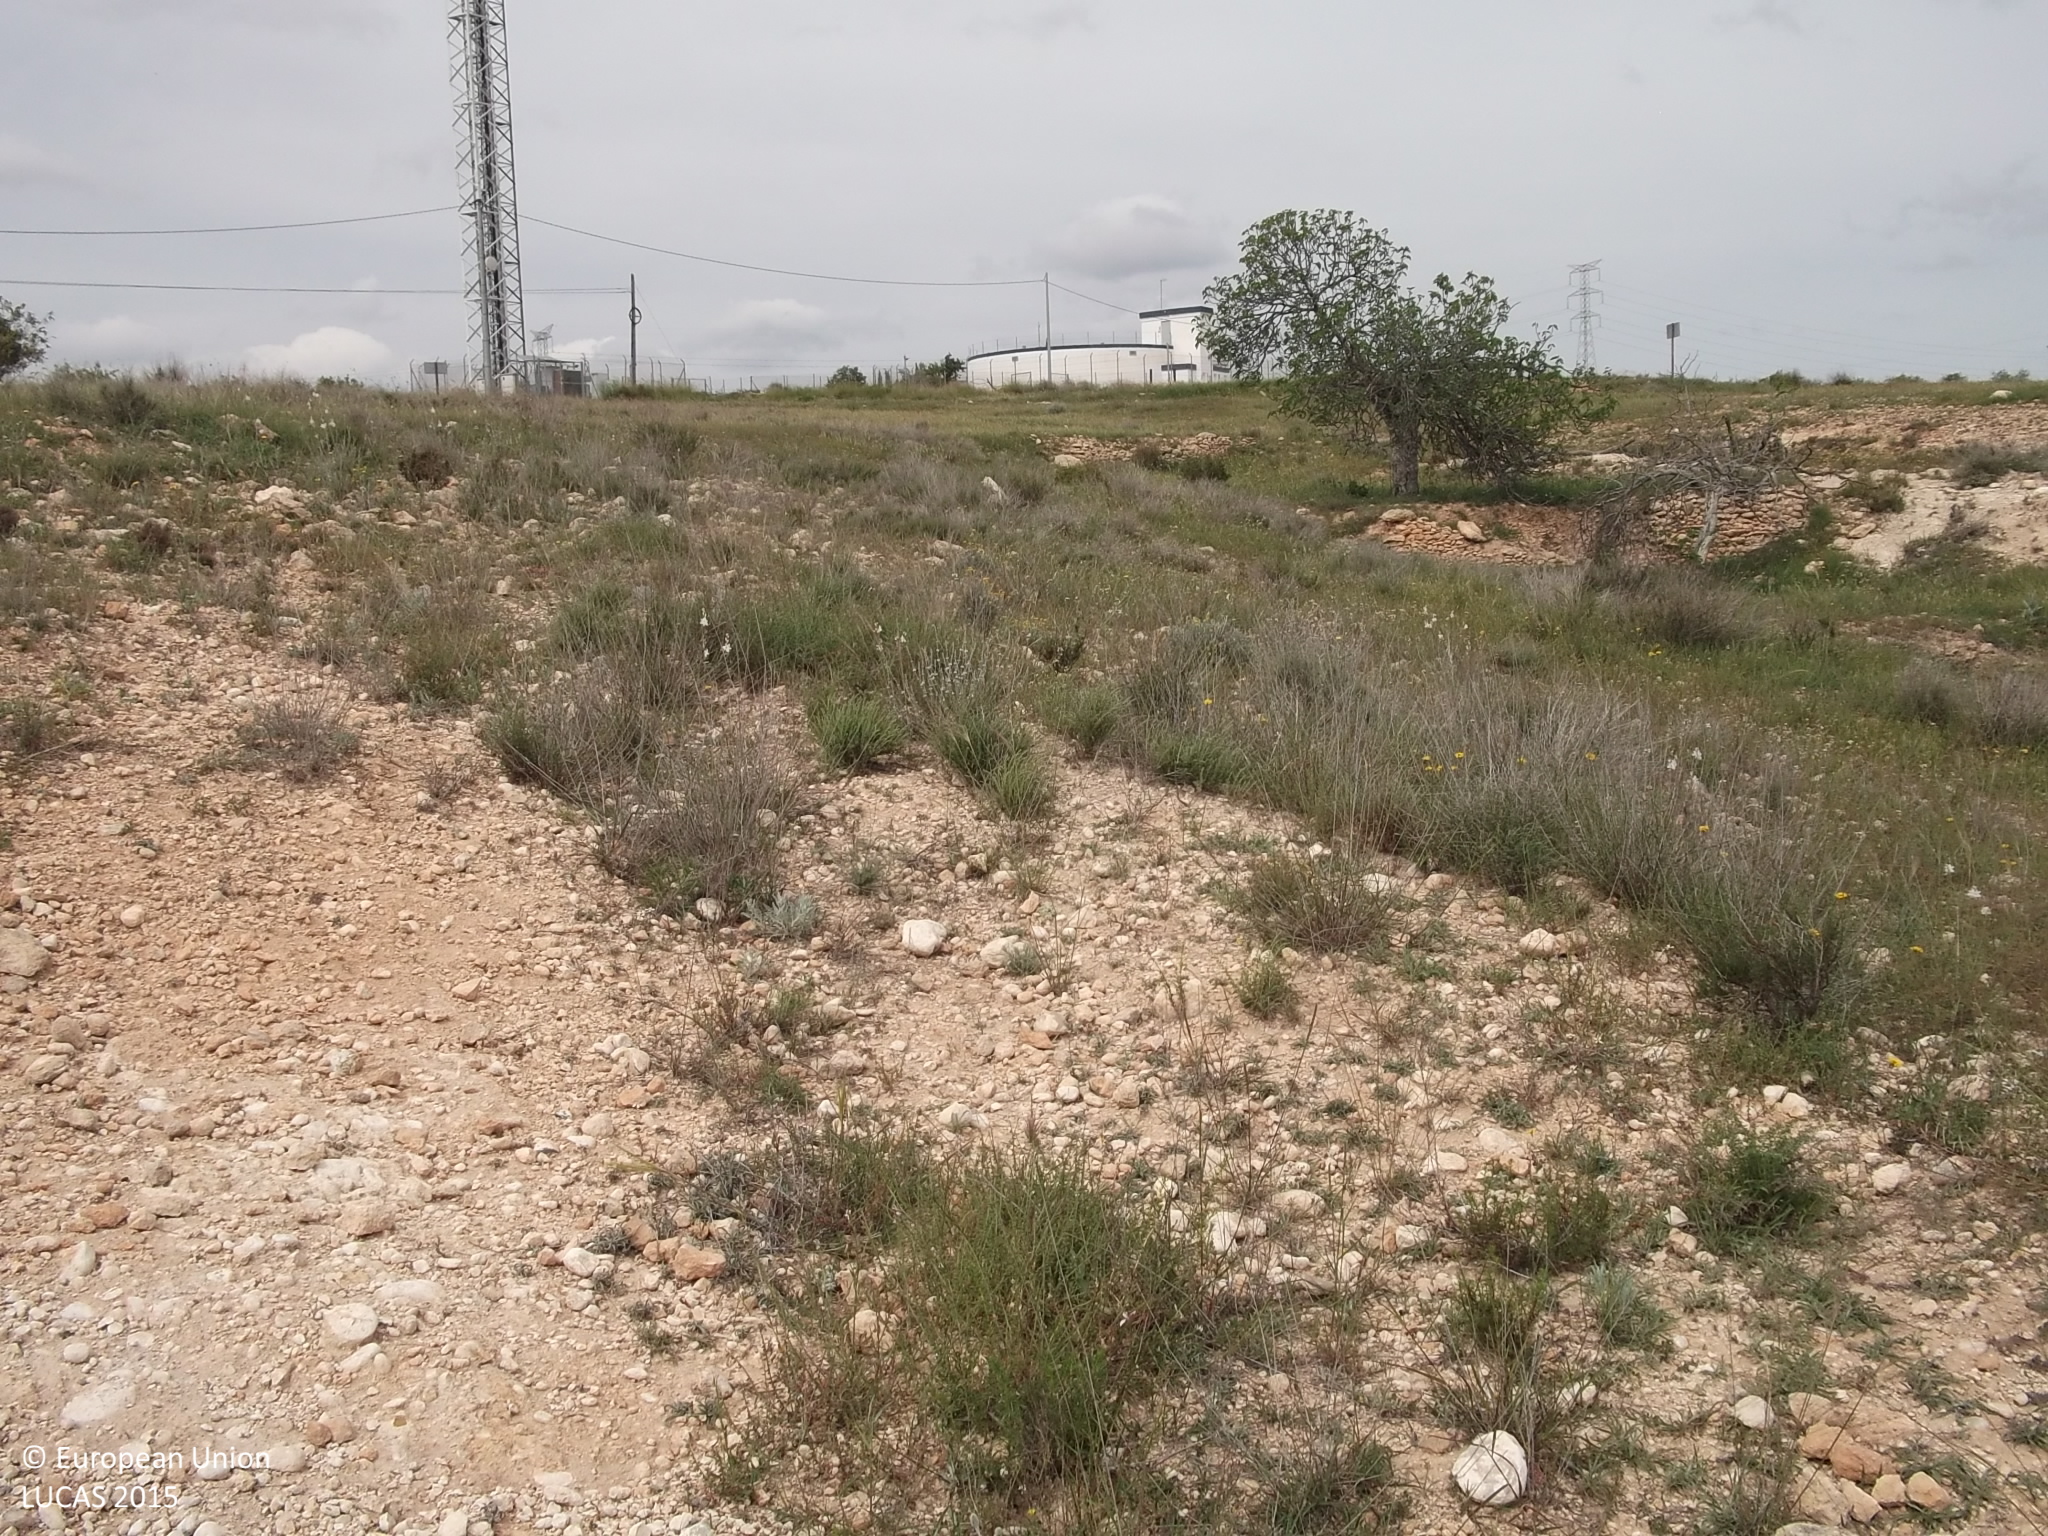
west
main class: Shrubland
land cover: Shrubland without tree cover
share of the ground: 25 - 50 %
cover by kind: herbaceous plants 40 %, shrubs 30 %, consolidated bare surface 30 %
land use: Semi-natural and natural areas not in use
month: April
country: ES
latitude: 37.9408
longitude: -1.3746
